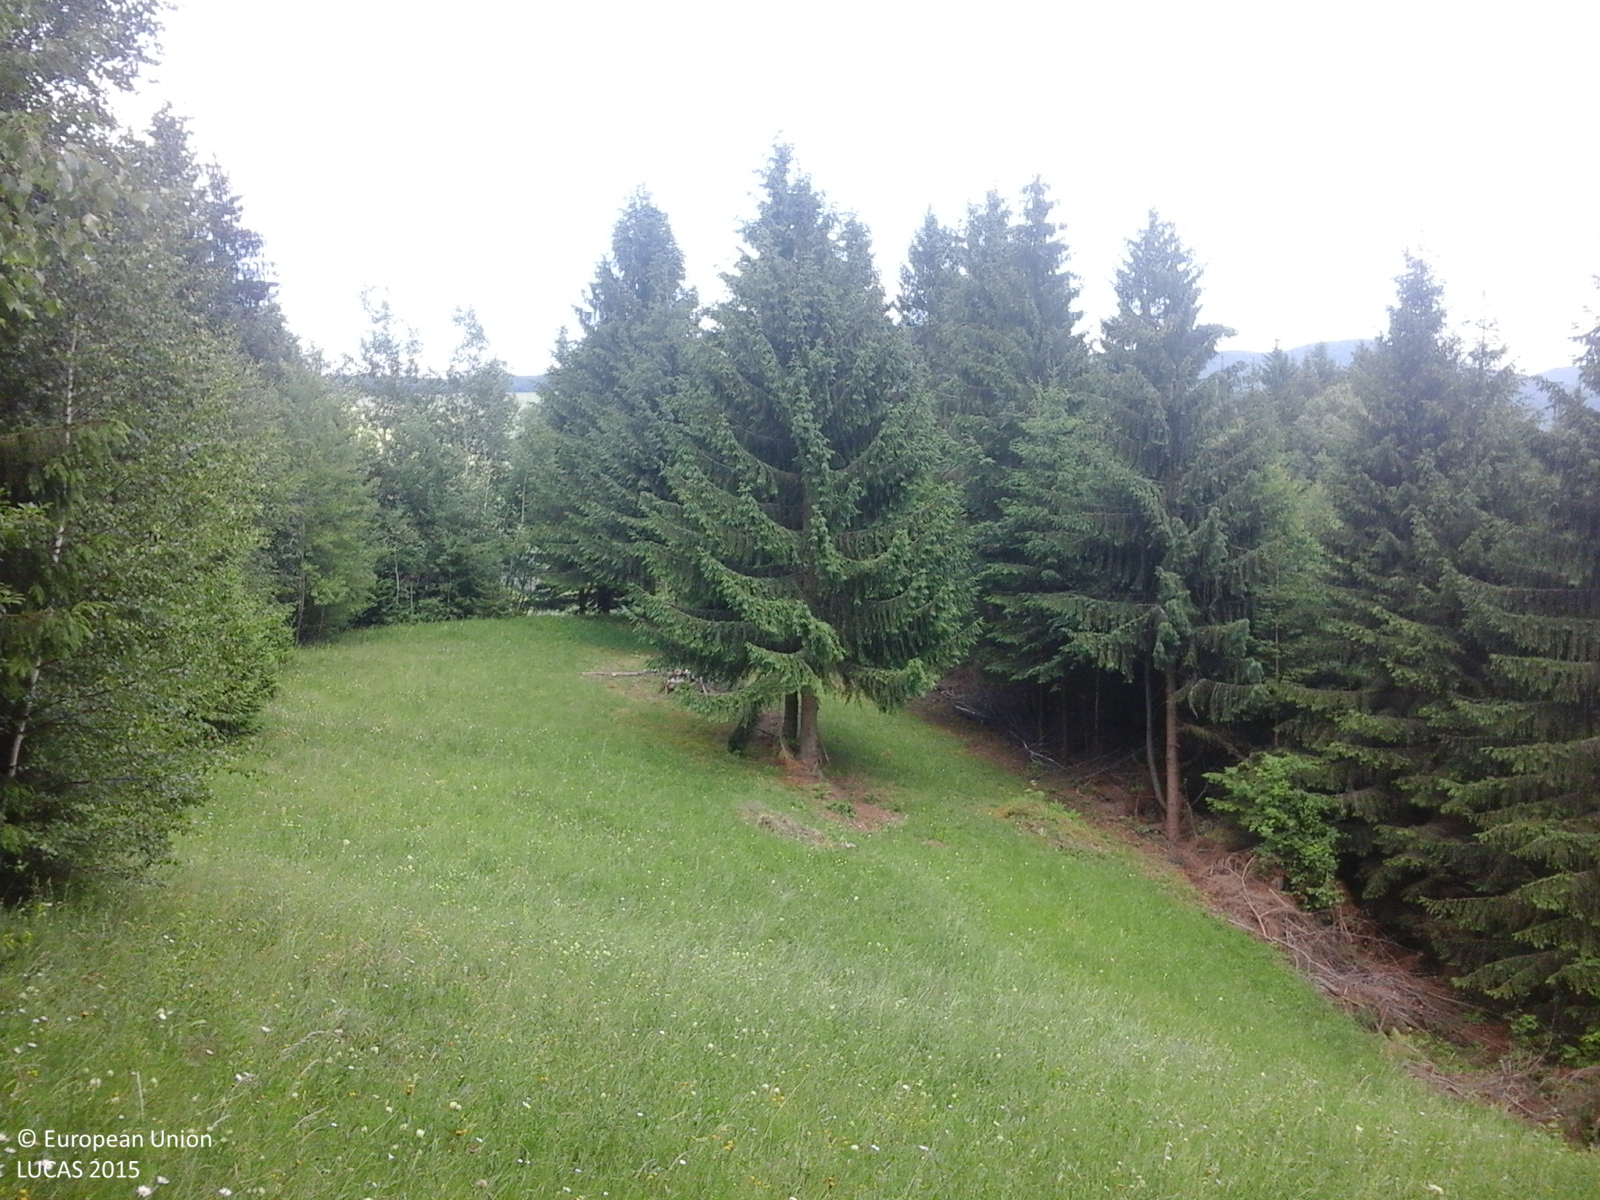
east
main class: Woodland
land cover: Spruce dominated mixed woodland
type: alpine coniferous forest
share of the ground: 50 - 75 %
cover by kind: coniferous forest trees 75 %, broadleaved forest trees 25 %
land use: Forestry
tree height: > 5 m
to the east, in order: Spruce dominated mixed woodland; Grassland with sparse tree/shrub cover; Broadleaved woodland; Grassland without tree/shrub cover; Single bushes/trees; Abandoned hedges; Grassland without tree/shrub cover
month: June
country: RO
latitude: 47.6480
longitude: 25.7659
